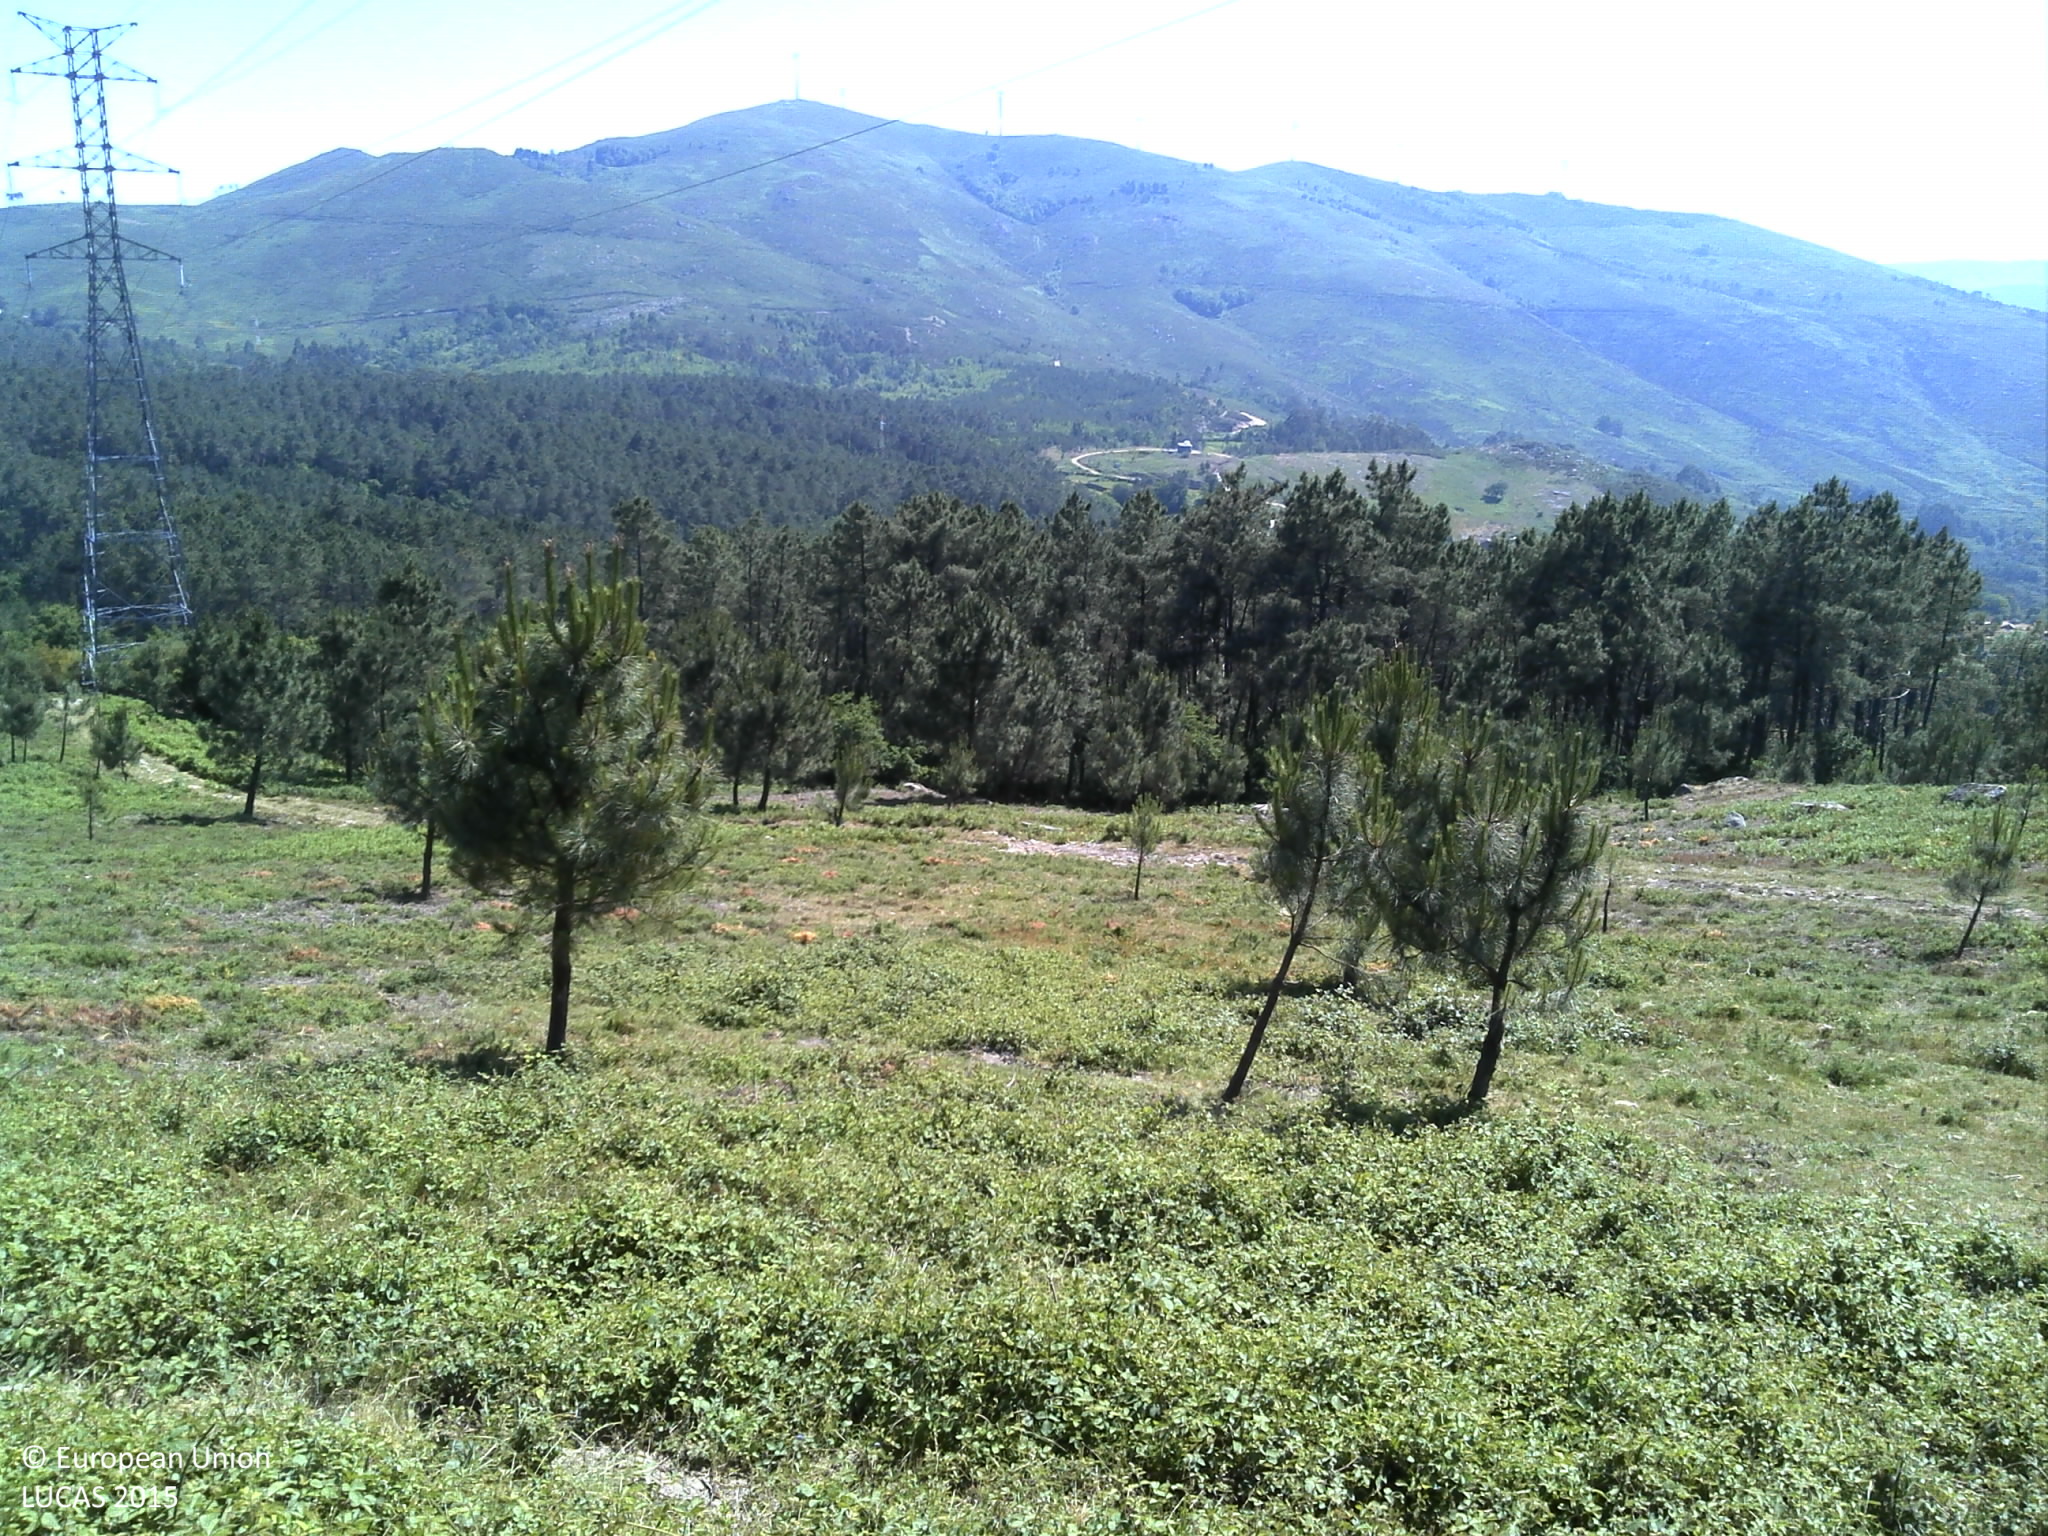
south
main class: Shrubland
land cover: Shrubland without tree cover
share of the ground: > 75 %
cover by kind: shrubs 80 %, herbaceous plants 10 %, unconsolidated bare surface 10 %
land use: Semi-natural and natural areas not in use
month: June
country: PT
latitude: 41.9991
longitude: -8.4270
